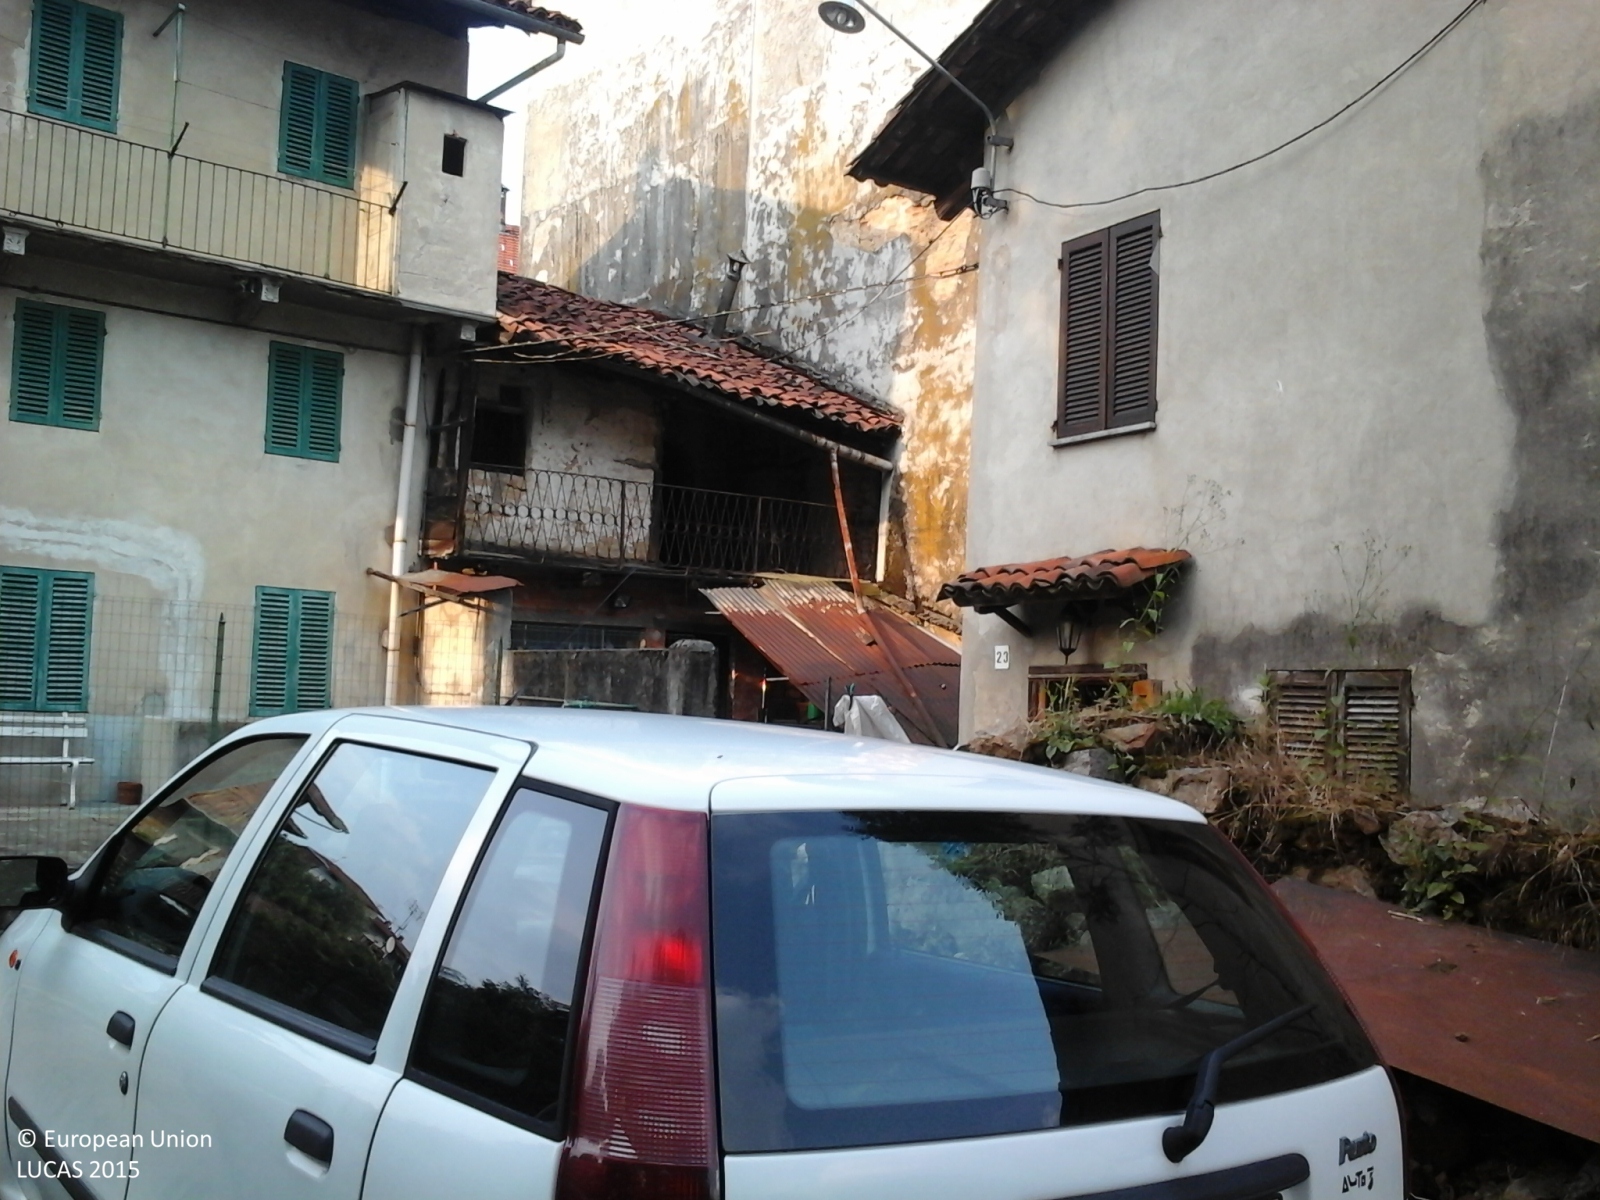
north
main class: Woodland
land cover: Broadleaved woodland
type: thermophilous deciduous forest
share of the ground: > 75 %
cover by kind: broadleaved forest trees 100 %
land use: Forestry
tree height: > 5 m
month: May
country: IT
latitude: 45.6147
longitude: 8.1691
